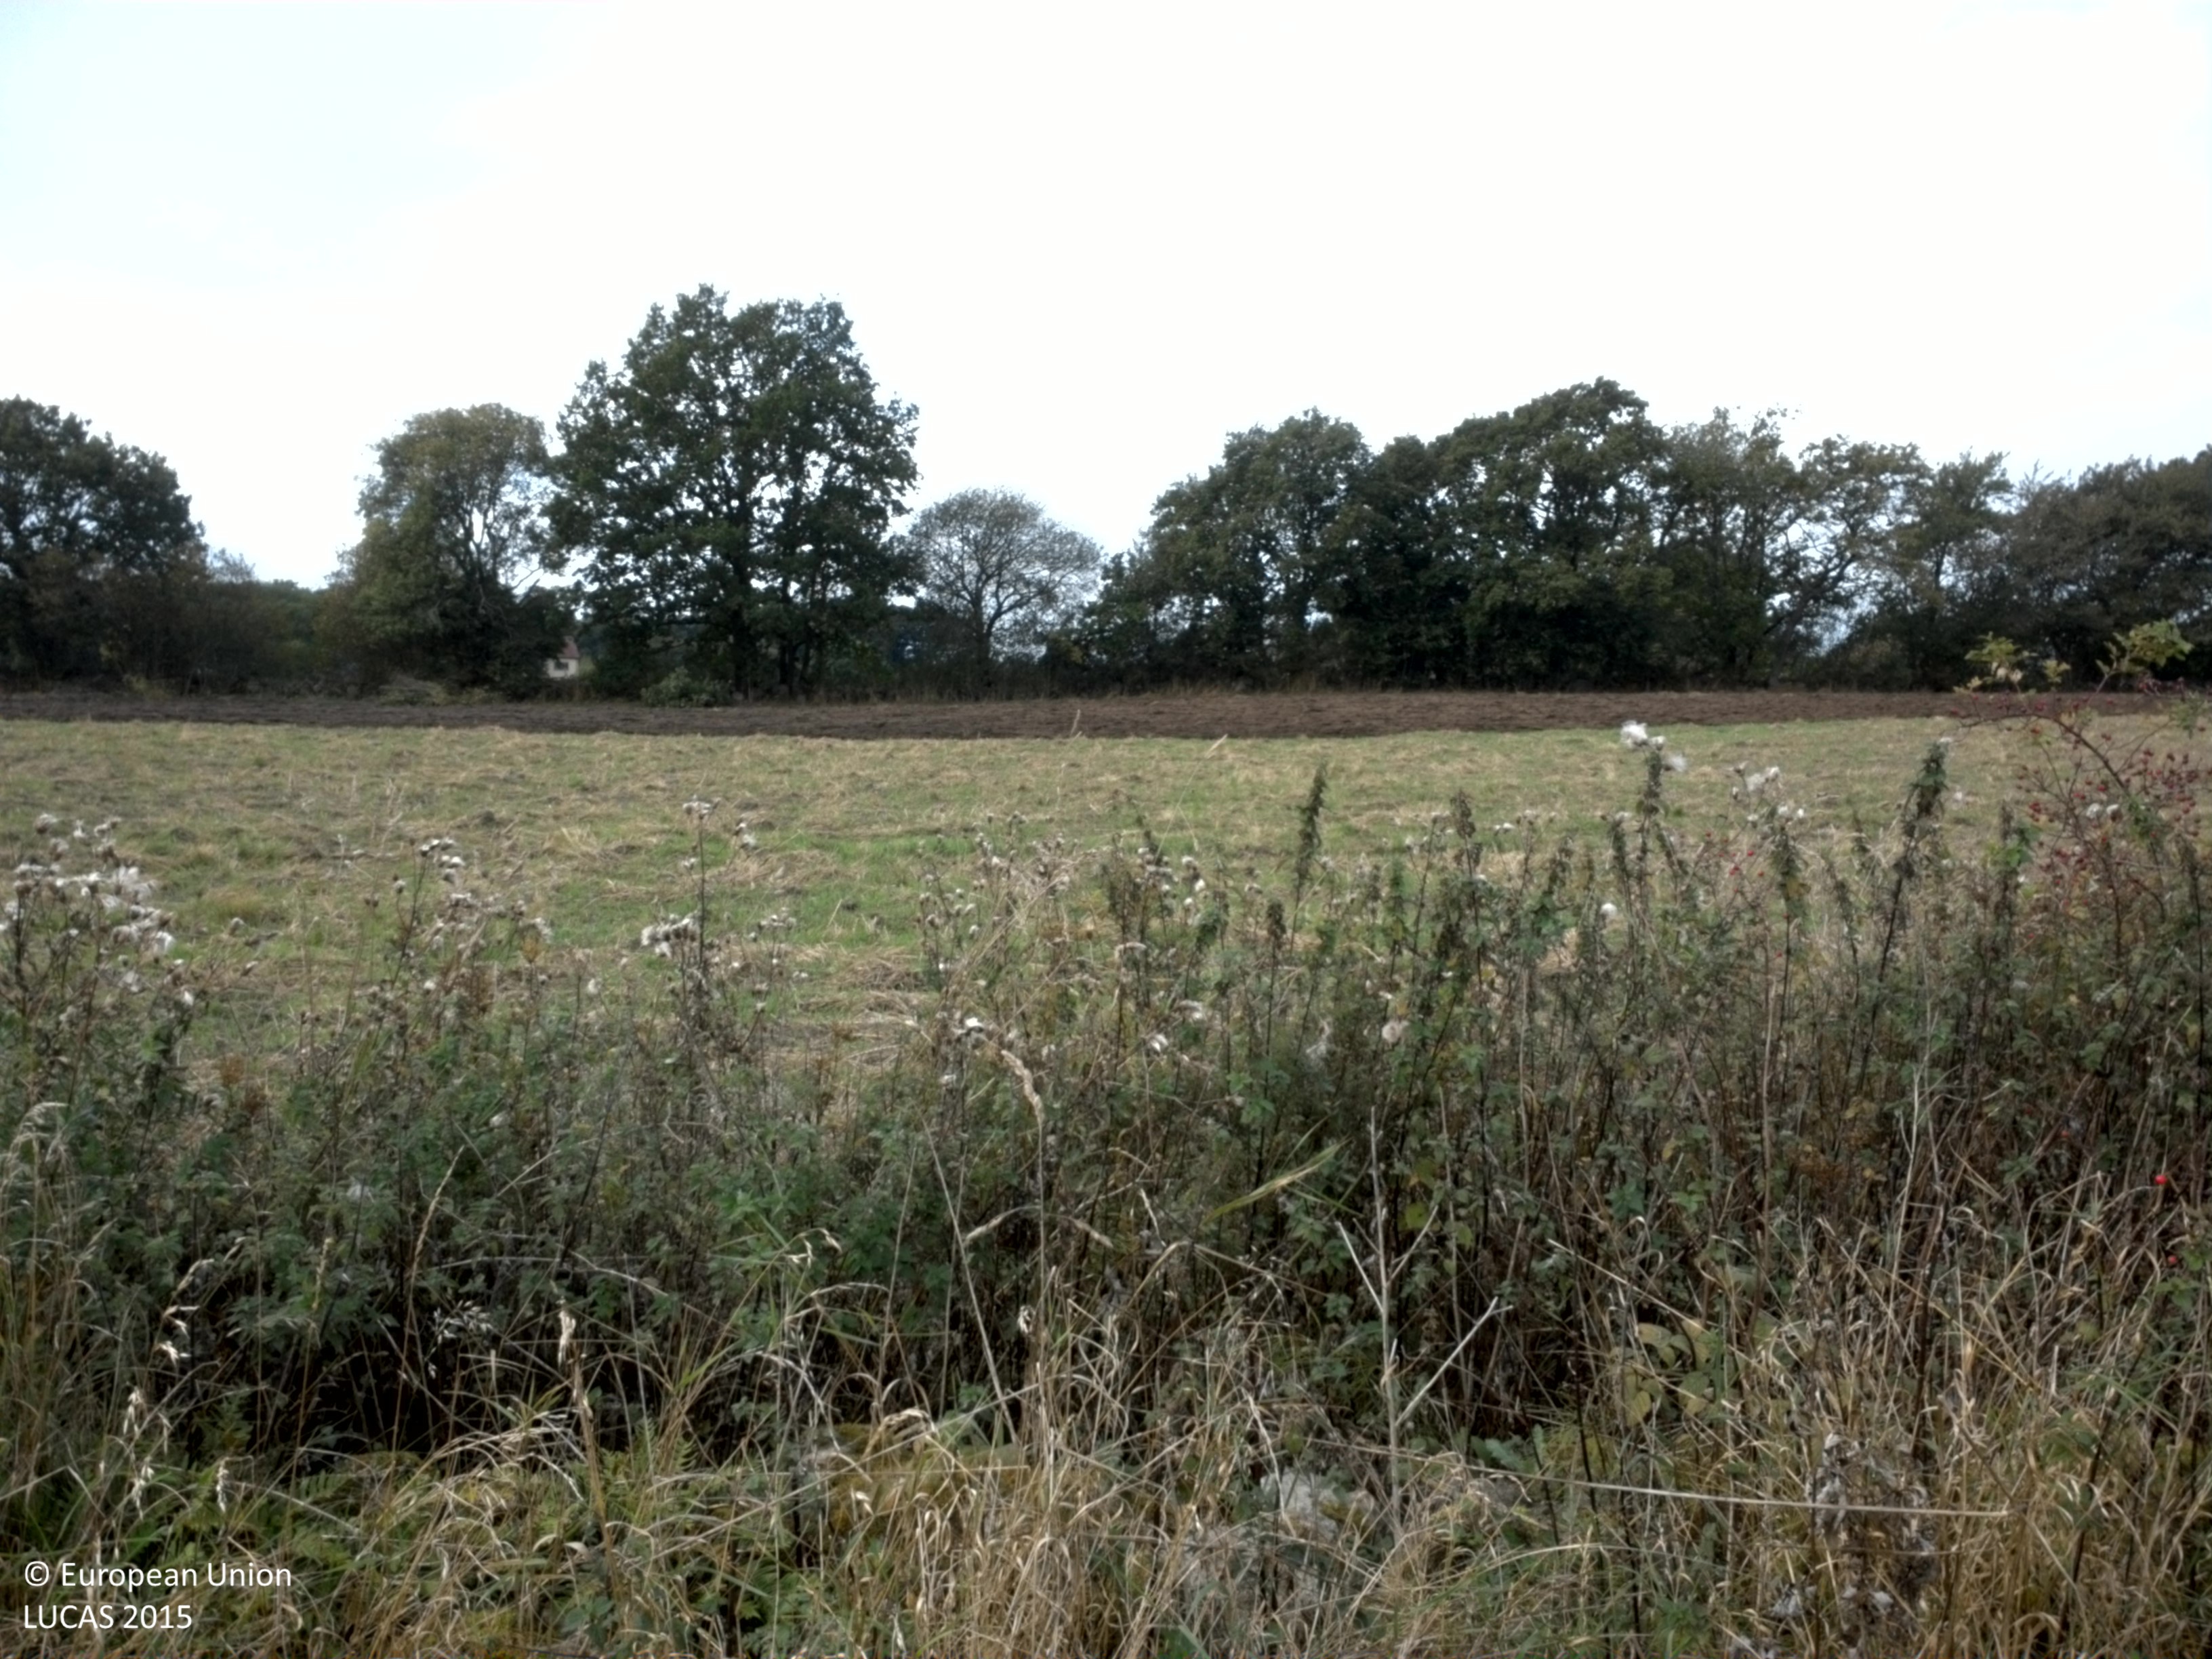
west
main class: Grassland
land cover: Grassland without tree/shrub cover
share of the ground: > 75 %
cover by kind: herbaceous plants 100 %
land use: Agriculture (excluding fallow land and kitchen gardens)
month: October
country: SE
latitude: 55.7383
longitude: 13.7091
